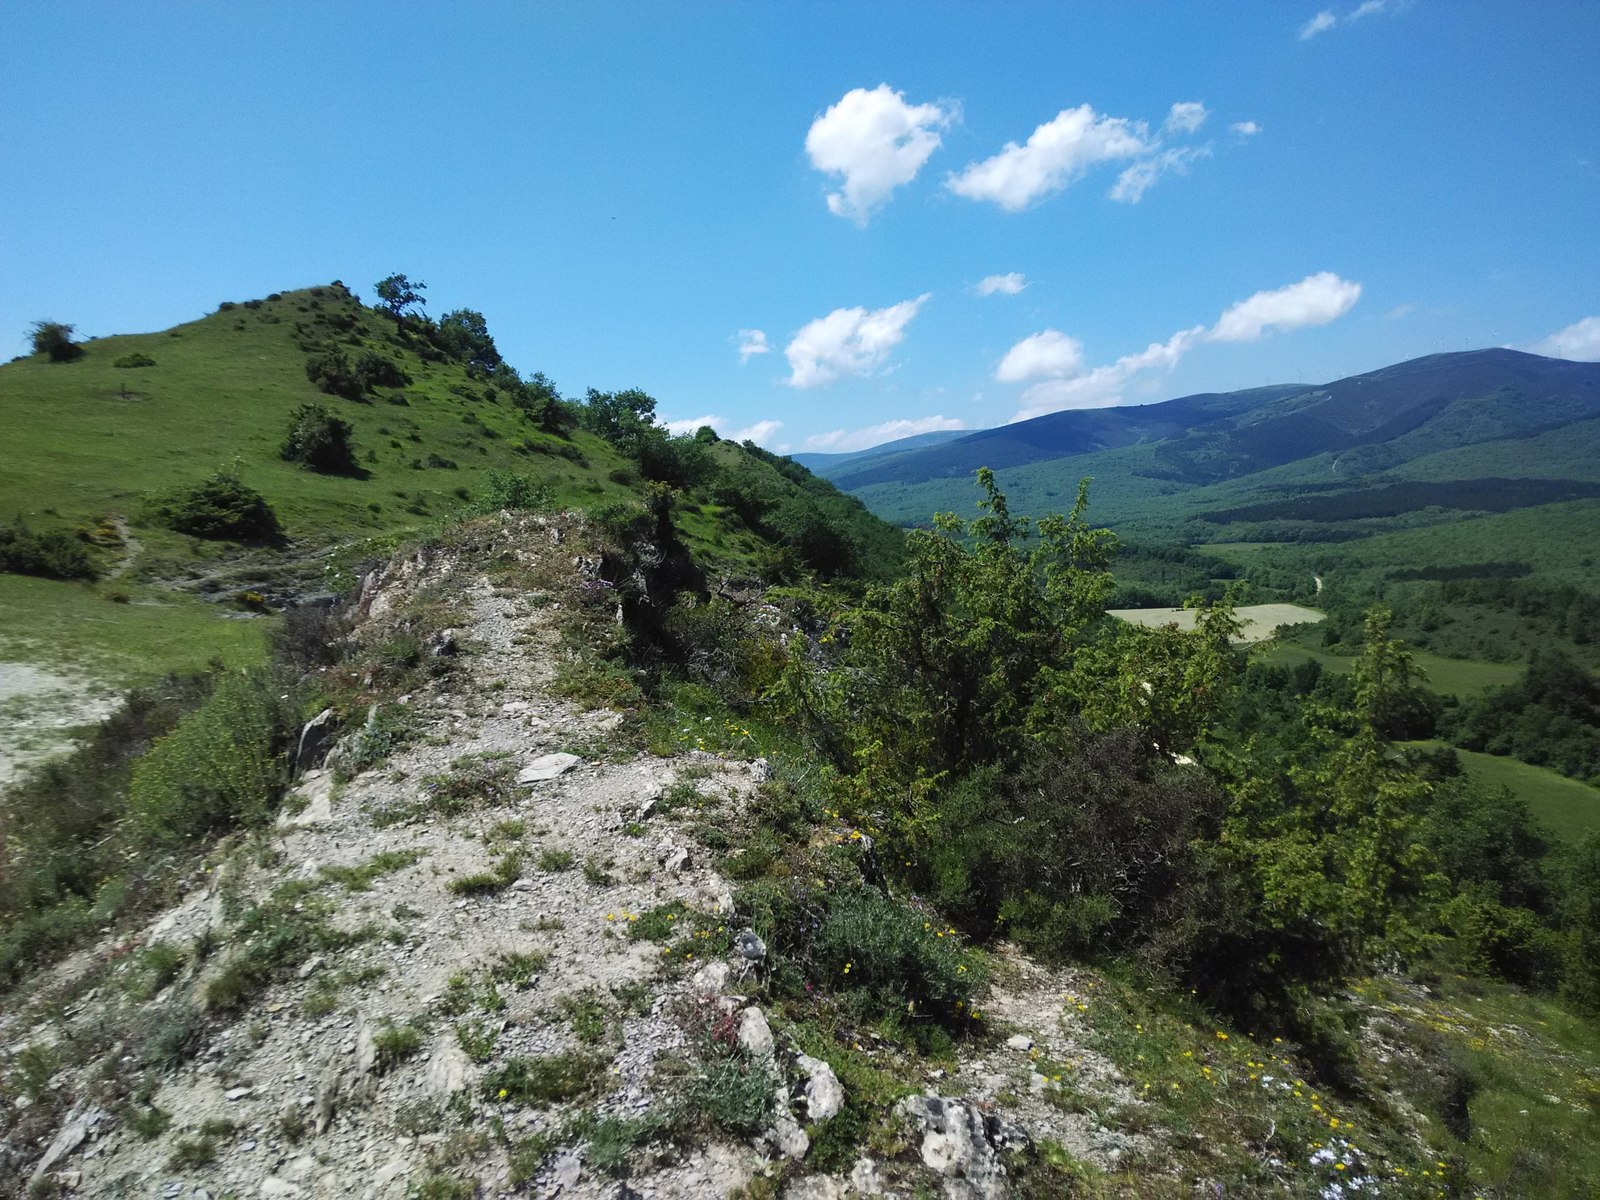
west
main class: Woodland
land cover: Broadleaved woodland
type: acidophilous oak and oak-birch forest
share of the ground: > 75 %
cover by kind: broadleaved forest trees 100 %
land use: Forestry
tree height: > 5 m
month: June
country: ES
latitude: 42.9334
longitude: -2.3630
